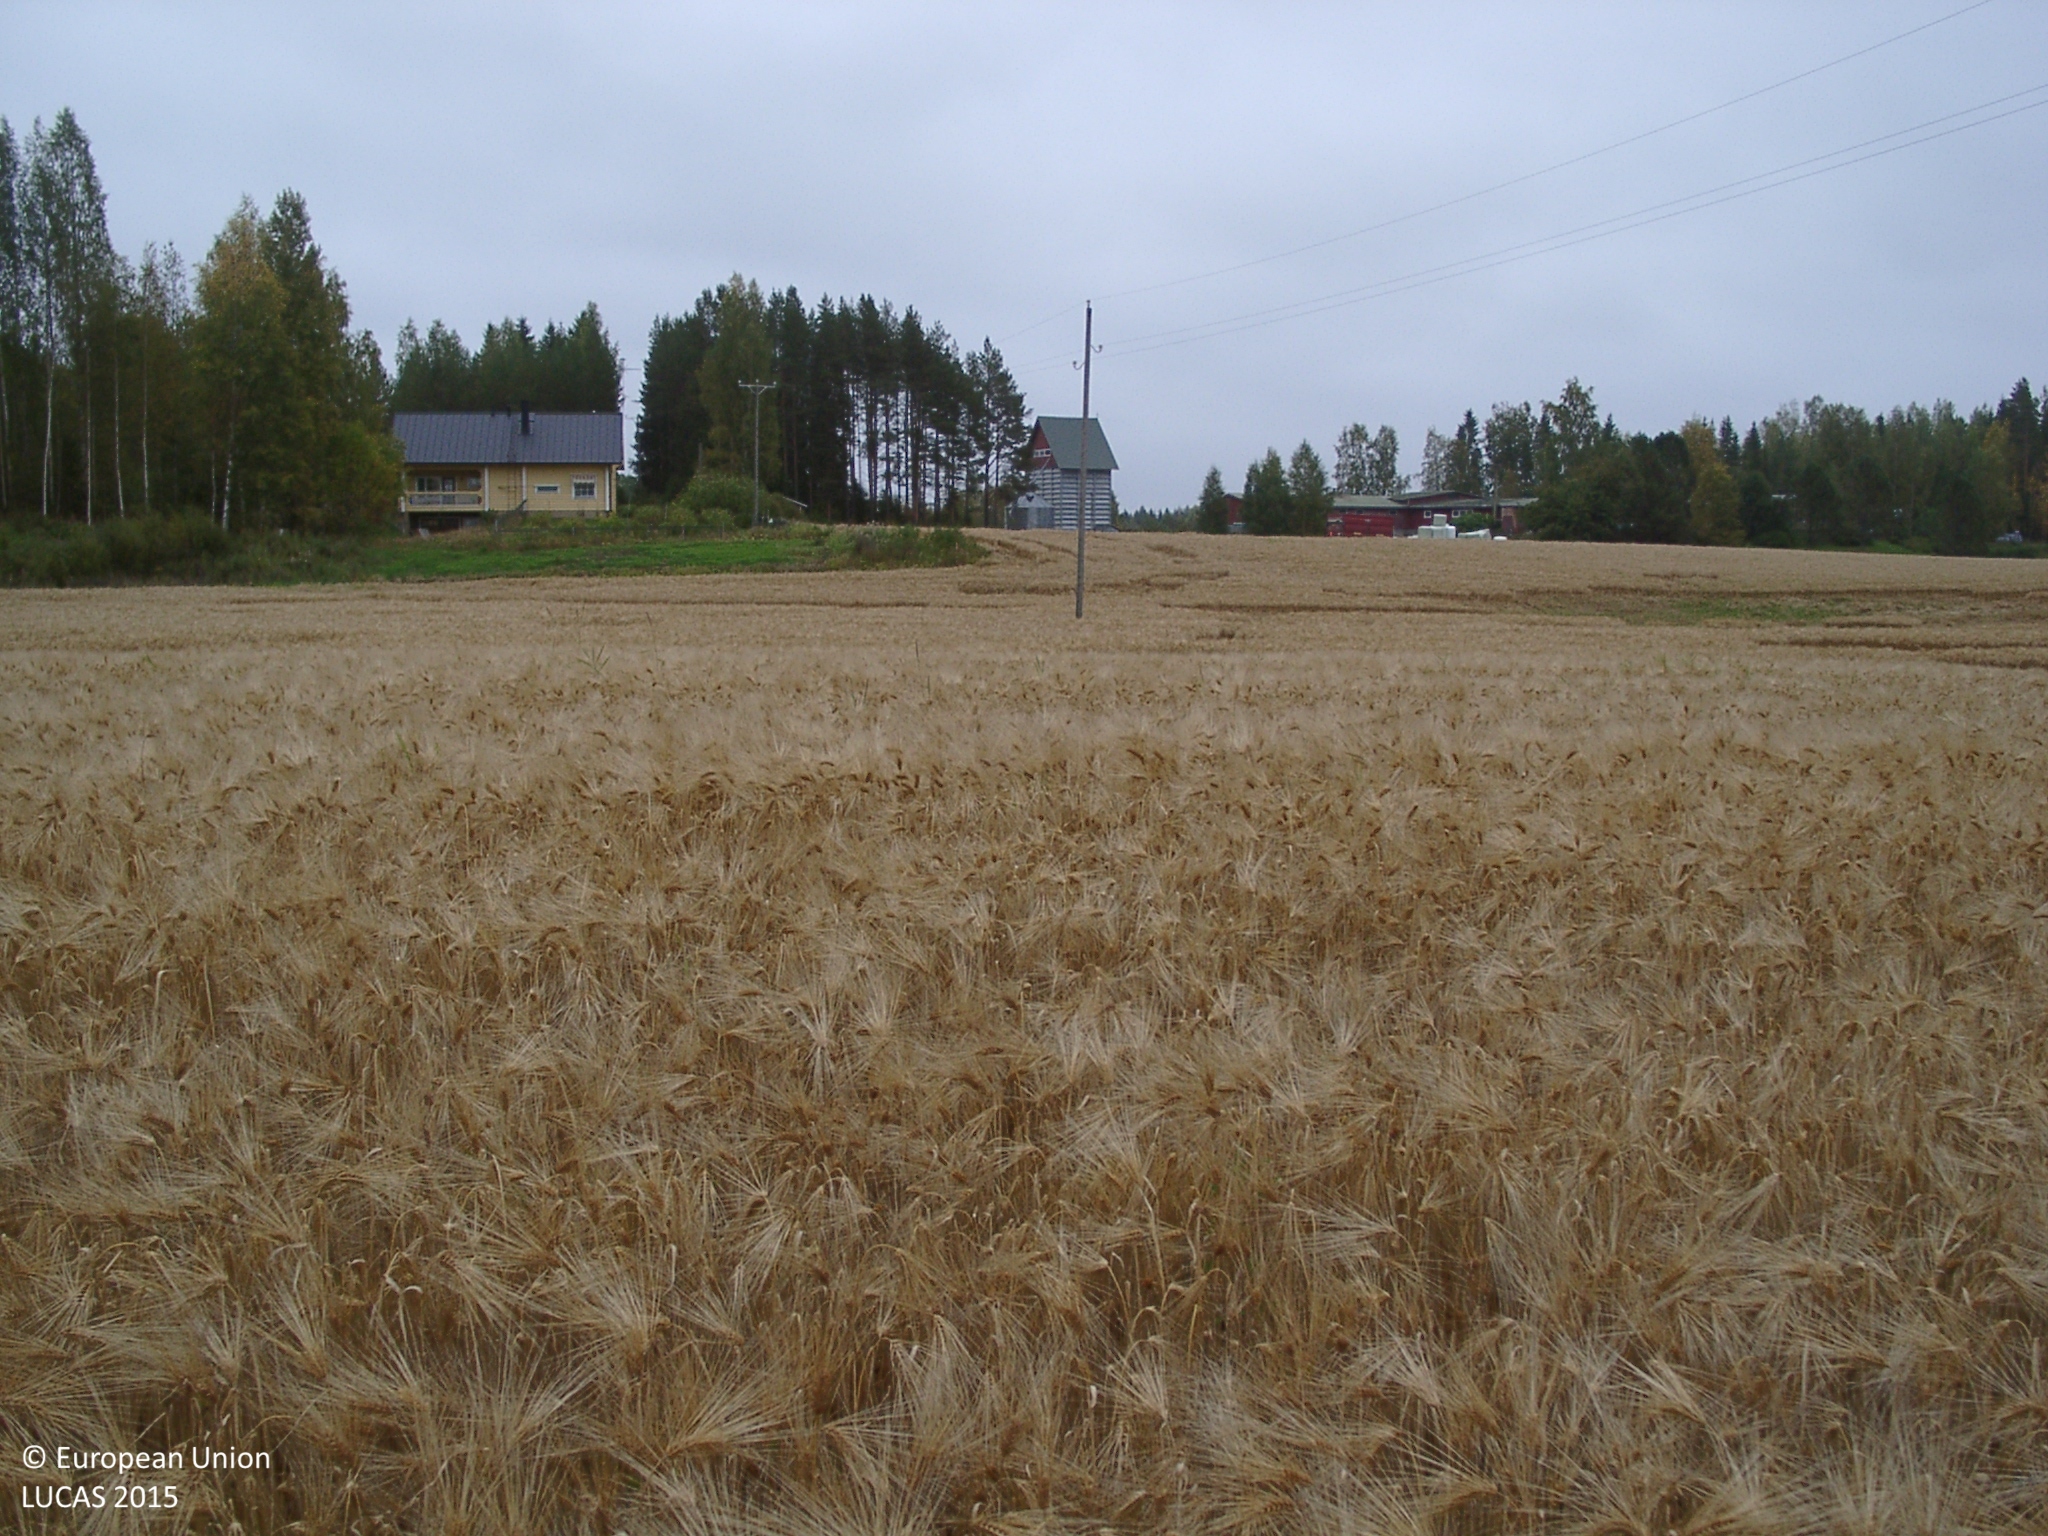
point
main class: Cropland
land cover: Barley
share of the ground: > 75 %
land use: Agriculture (excluding fallow land and kitchen gardens)
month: September
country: FI
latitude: 62.7531
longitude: 25.7588
